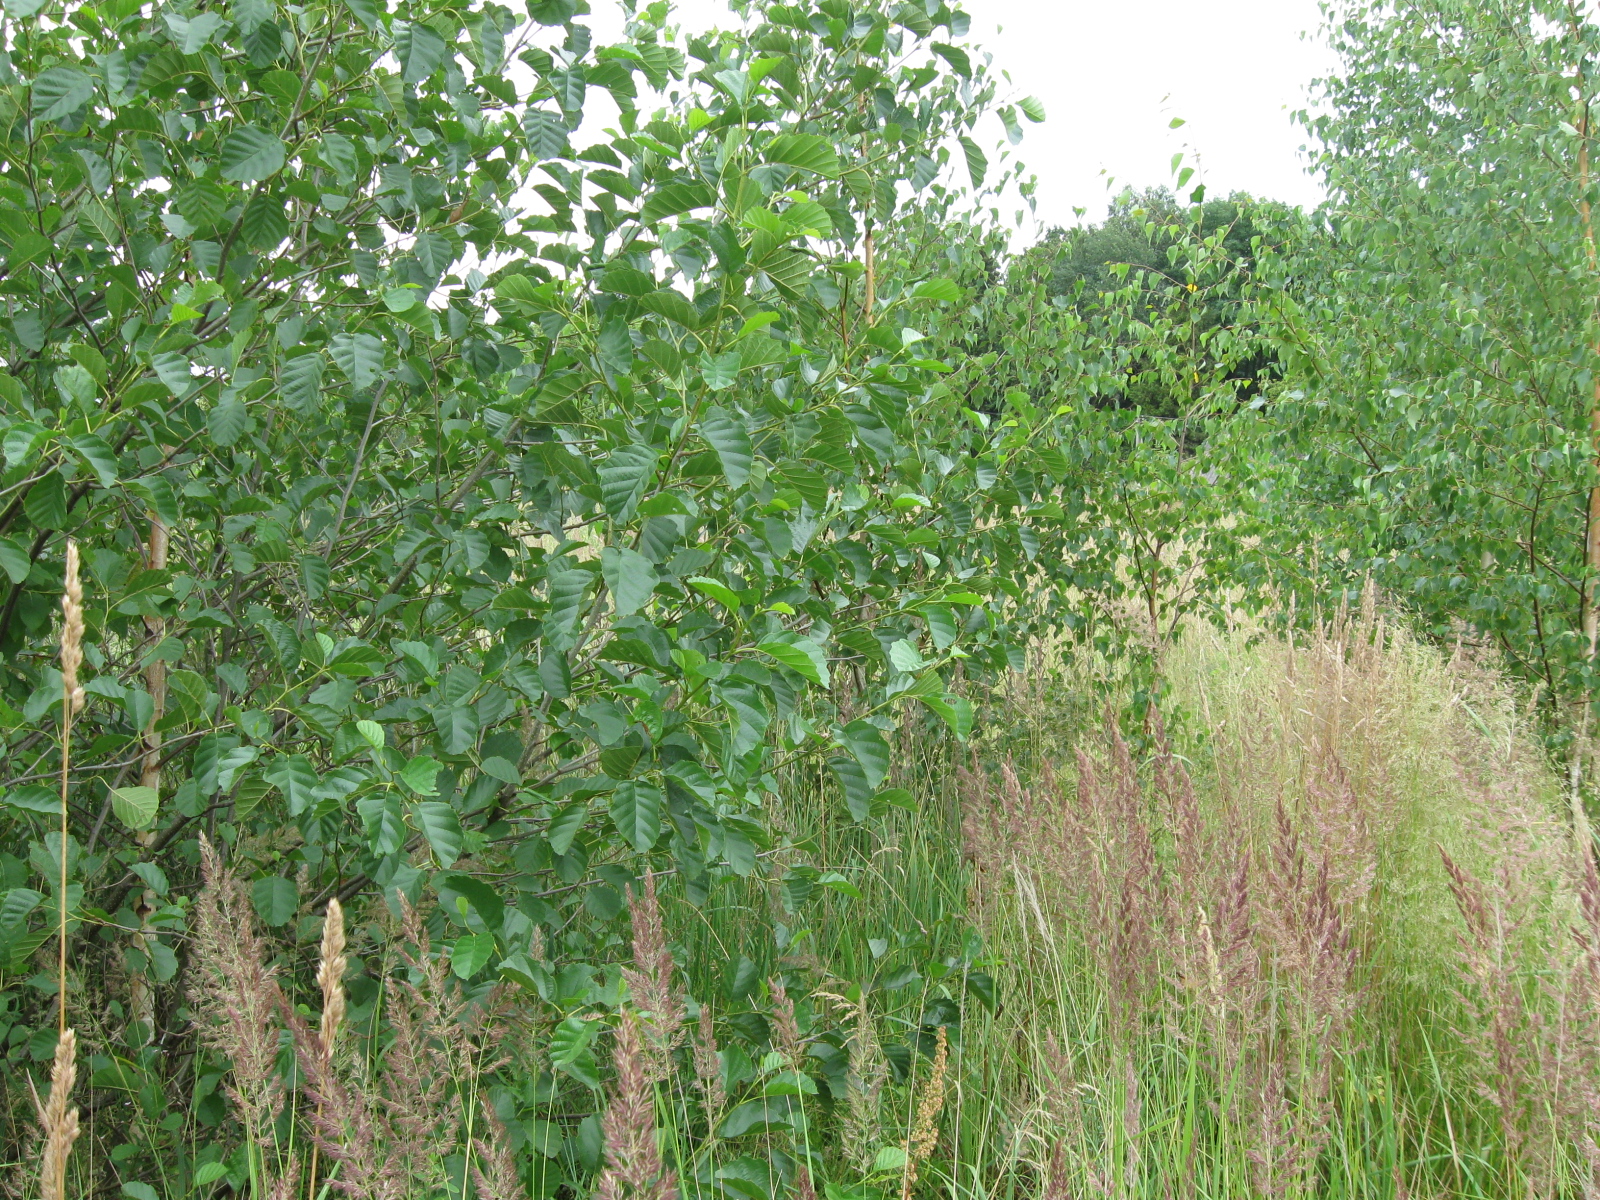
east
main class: Woodland
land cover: Broadleaved woodland
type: non-riverine alder, birch or aspen forest
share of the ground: 25 - 50 %
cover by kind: herbaceous plants 75 %, broadleaved forest trees 25 %
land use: Semi-natural and natural areas not in use
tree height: < 5 m
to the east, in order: Broadleaved woodland; Grassland with sparse tree/shrub cover; Apple fruit; Spontaneously vegetated surfaces; Electric lines; Spontaneously vegetated surfaces; Tracks; Electric lines; Shruby margins; Ditches and canals; Spontaneously vegetated surfaces; Other mixed woodland
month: July
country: LT
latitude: 54.8408
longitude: 23.7419
